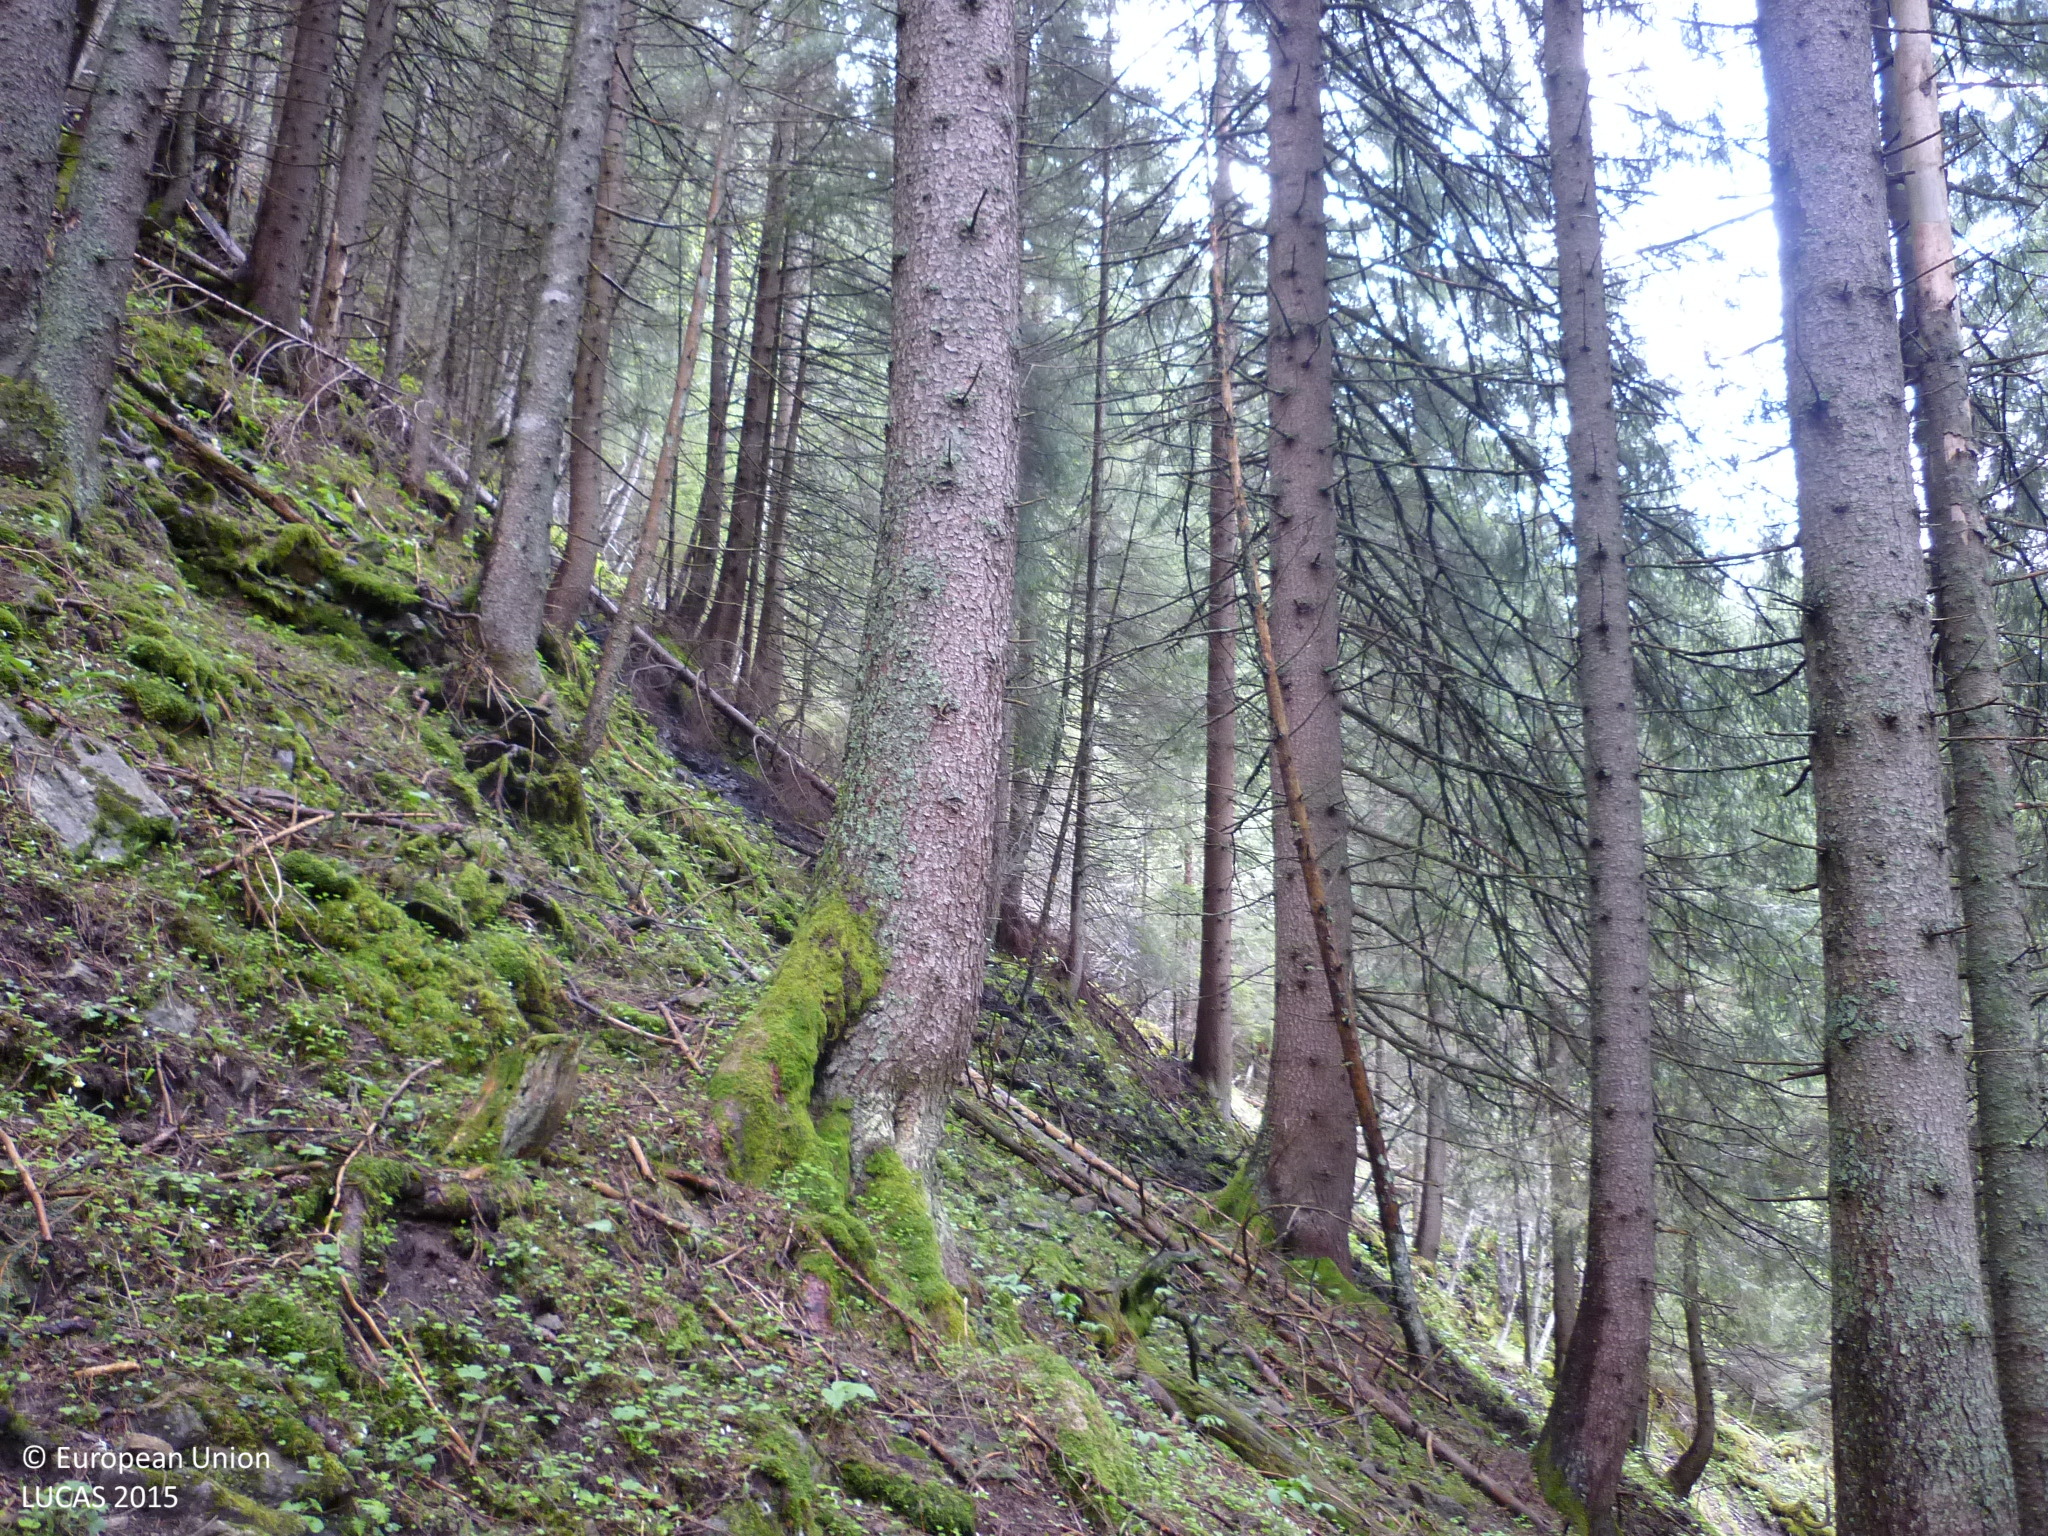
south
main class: Woodland
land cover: Spruce dominated coniferous woodland
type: alpine coniferous forest
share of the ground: > 75 %
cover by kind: coniferous forest trees 85 %, herbaceous plants 5 %, lichens and mosses 5 %, unconsolidated bare surface 5 %
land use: Forestry
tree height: > 5 m
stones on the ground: 10 - 25 %
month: May
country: AT
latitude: 47.3029
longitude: 14.0323
